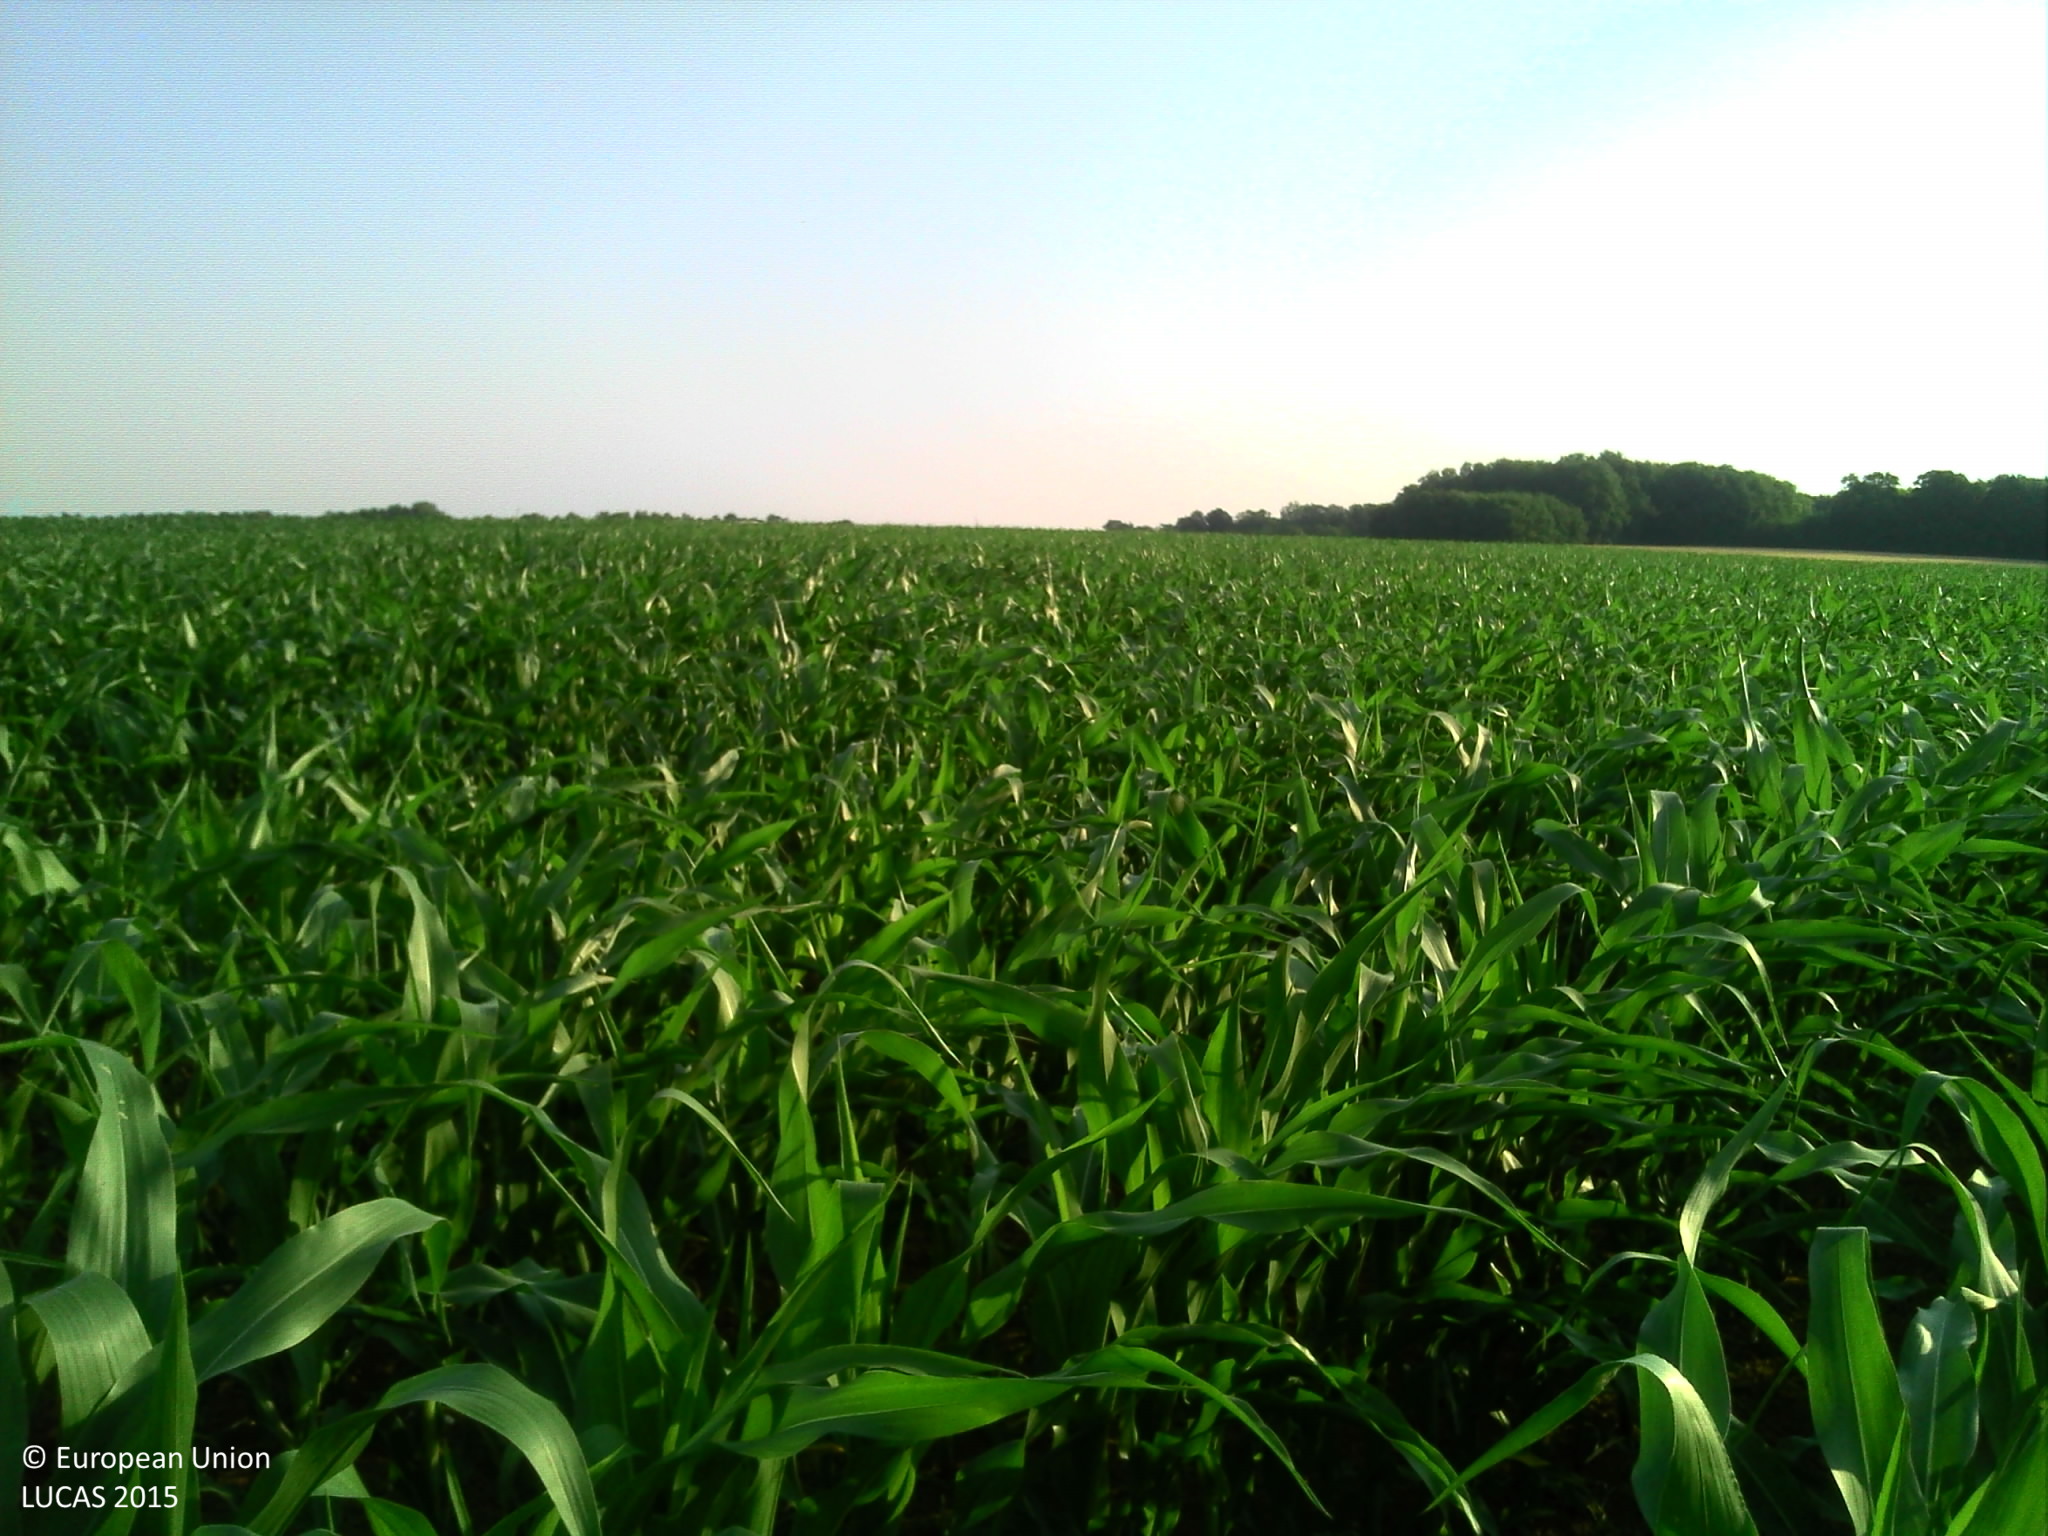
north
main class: Cropland
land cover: Maize
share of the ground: 25 - 50 %
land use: Agriculture (excluding fallow land and kitchen gardens)
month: July
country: FR
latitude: 48.8013
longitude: 5.1379
